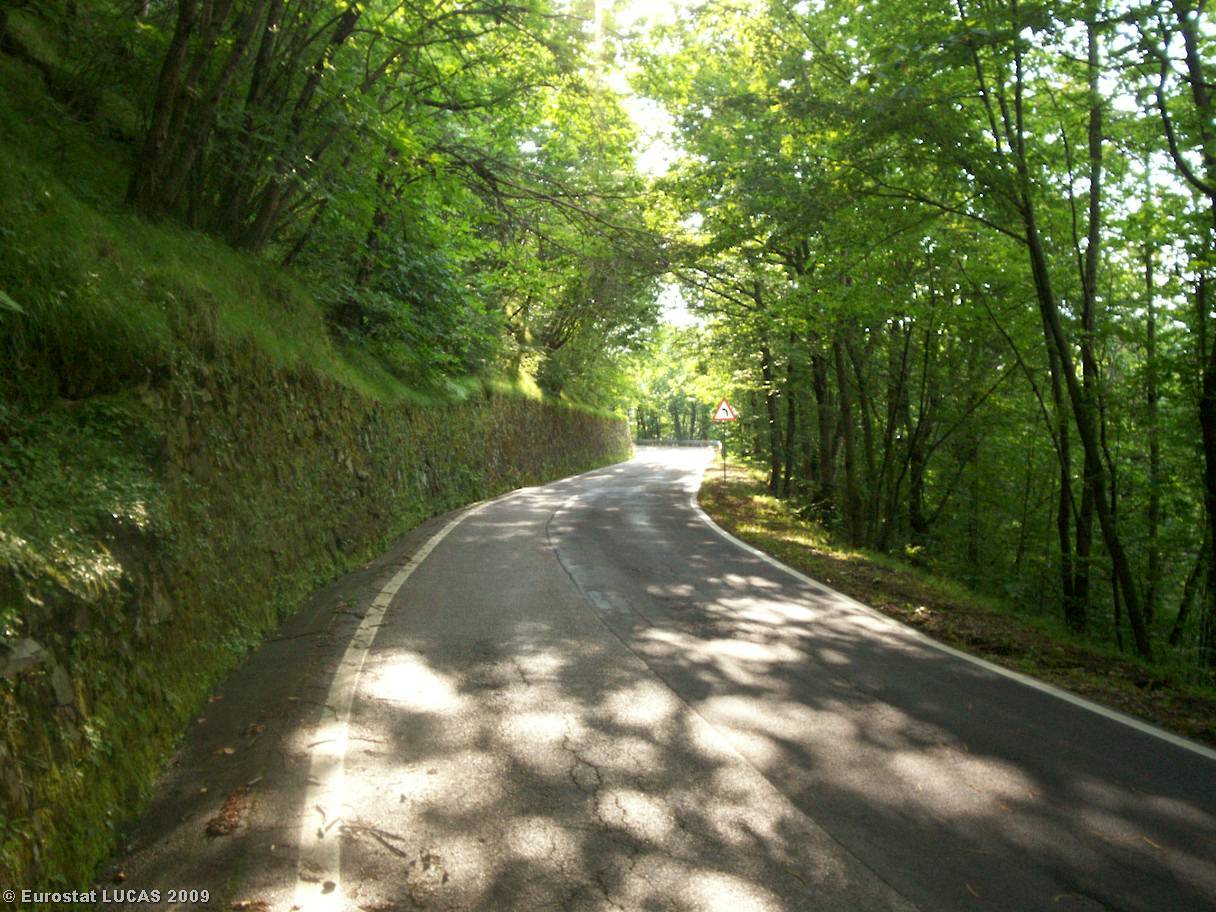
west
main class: Woodland
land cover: Broadleaved woodland
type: thermophilous deciduous forest
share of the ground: > 75 %
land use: Forestry
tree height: > 5 m
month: July
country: IT
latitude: 44.1335
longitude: 10.3367
